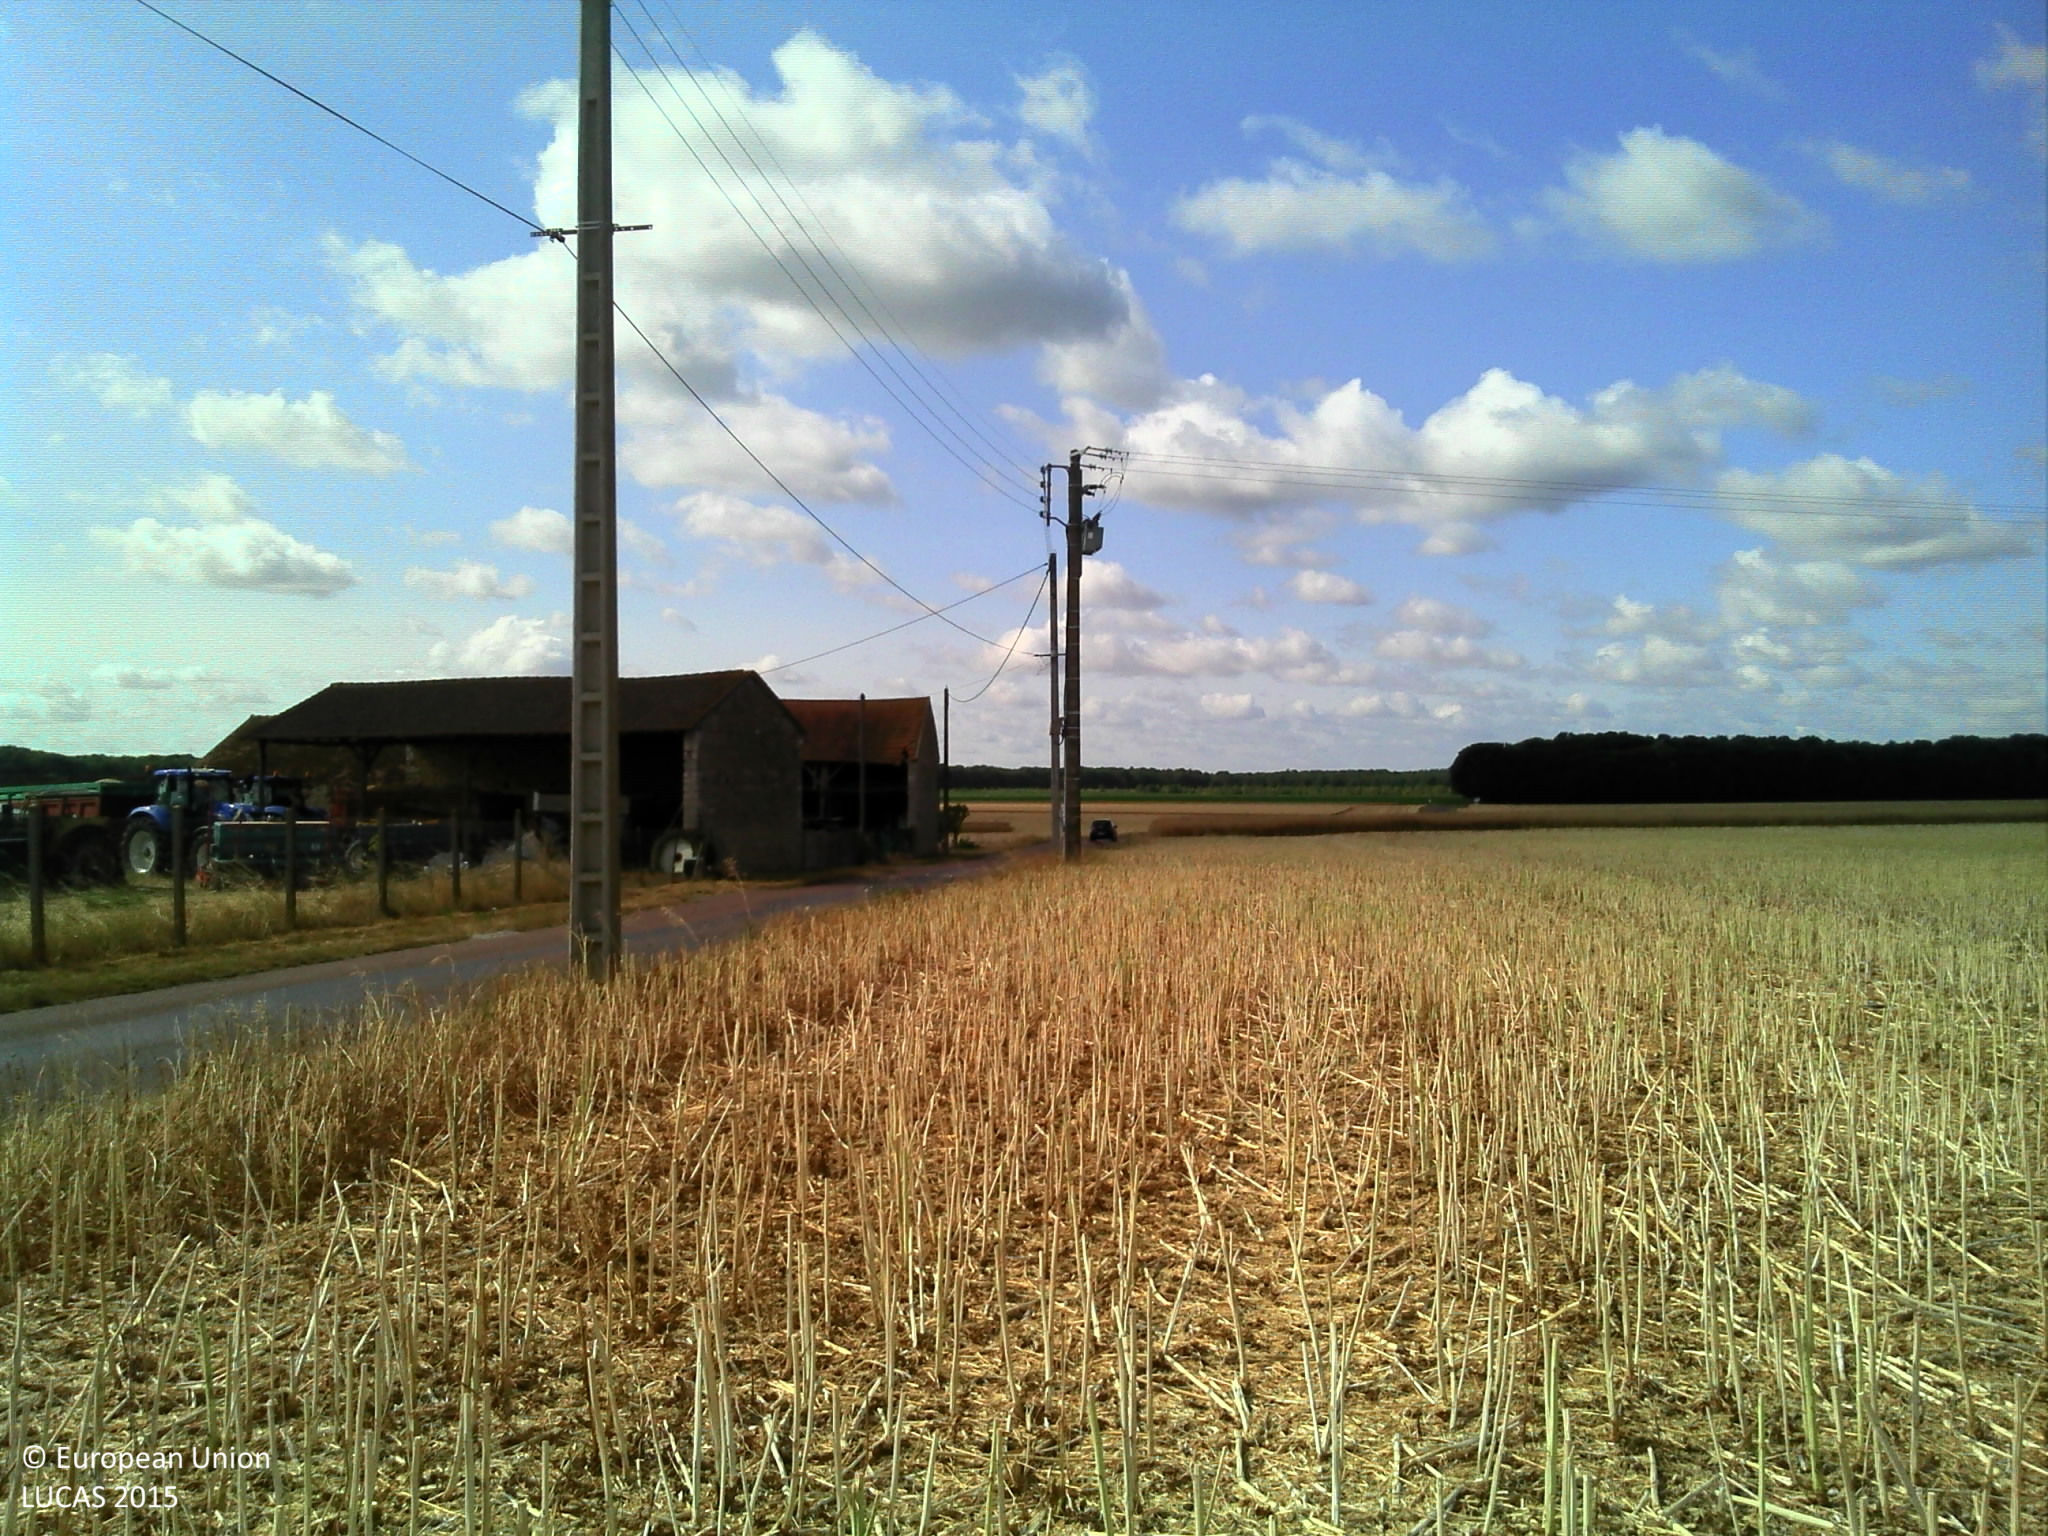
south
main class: Cropland
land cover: Rape and turnip rape
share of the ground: > 75 %
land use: Agriculture (excluding fallow land and kitchen gardens)
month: July
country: FR
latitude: 48.0772
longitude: 2.7838
